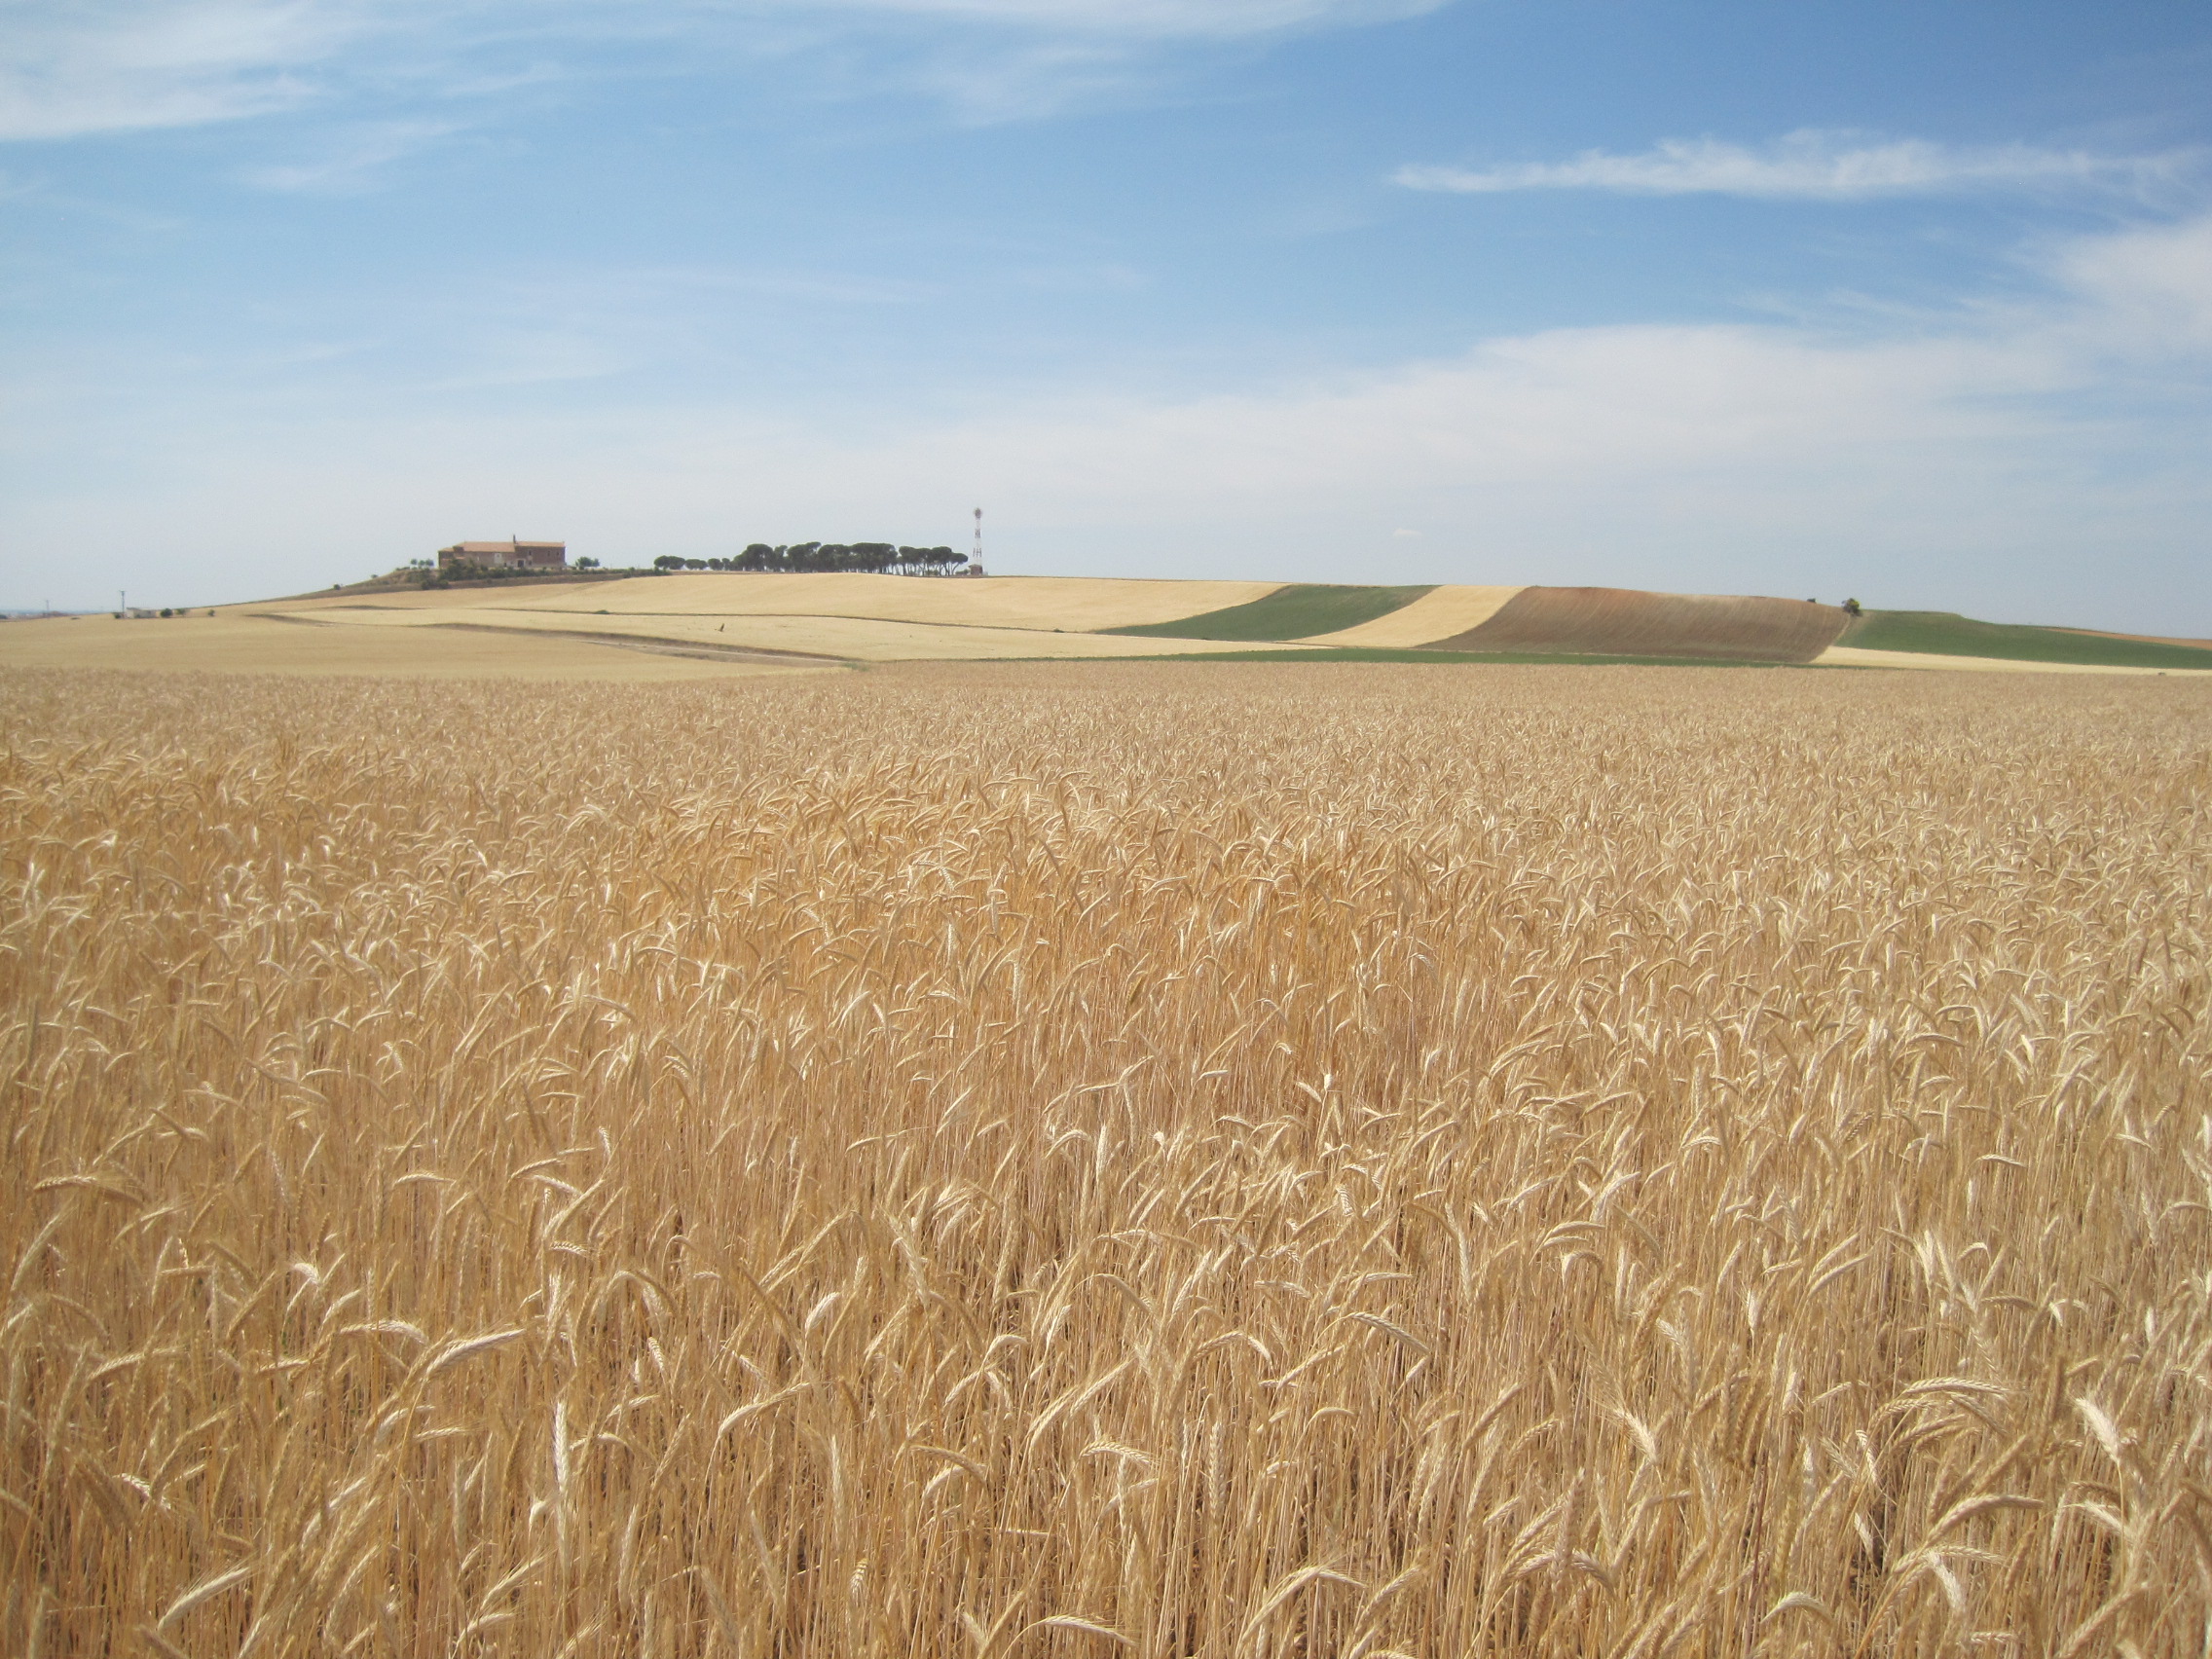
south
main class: Cropland
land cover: Triticale
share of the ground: > 75 %
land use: Agriculture (excluding fallow land and kitchen gardens)
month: June
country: ES
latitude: 41.3501
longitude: -5.0954
